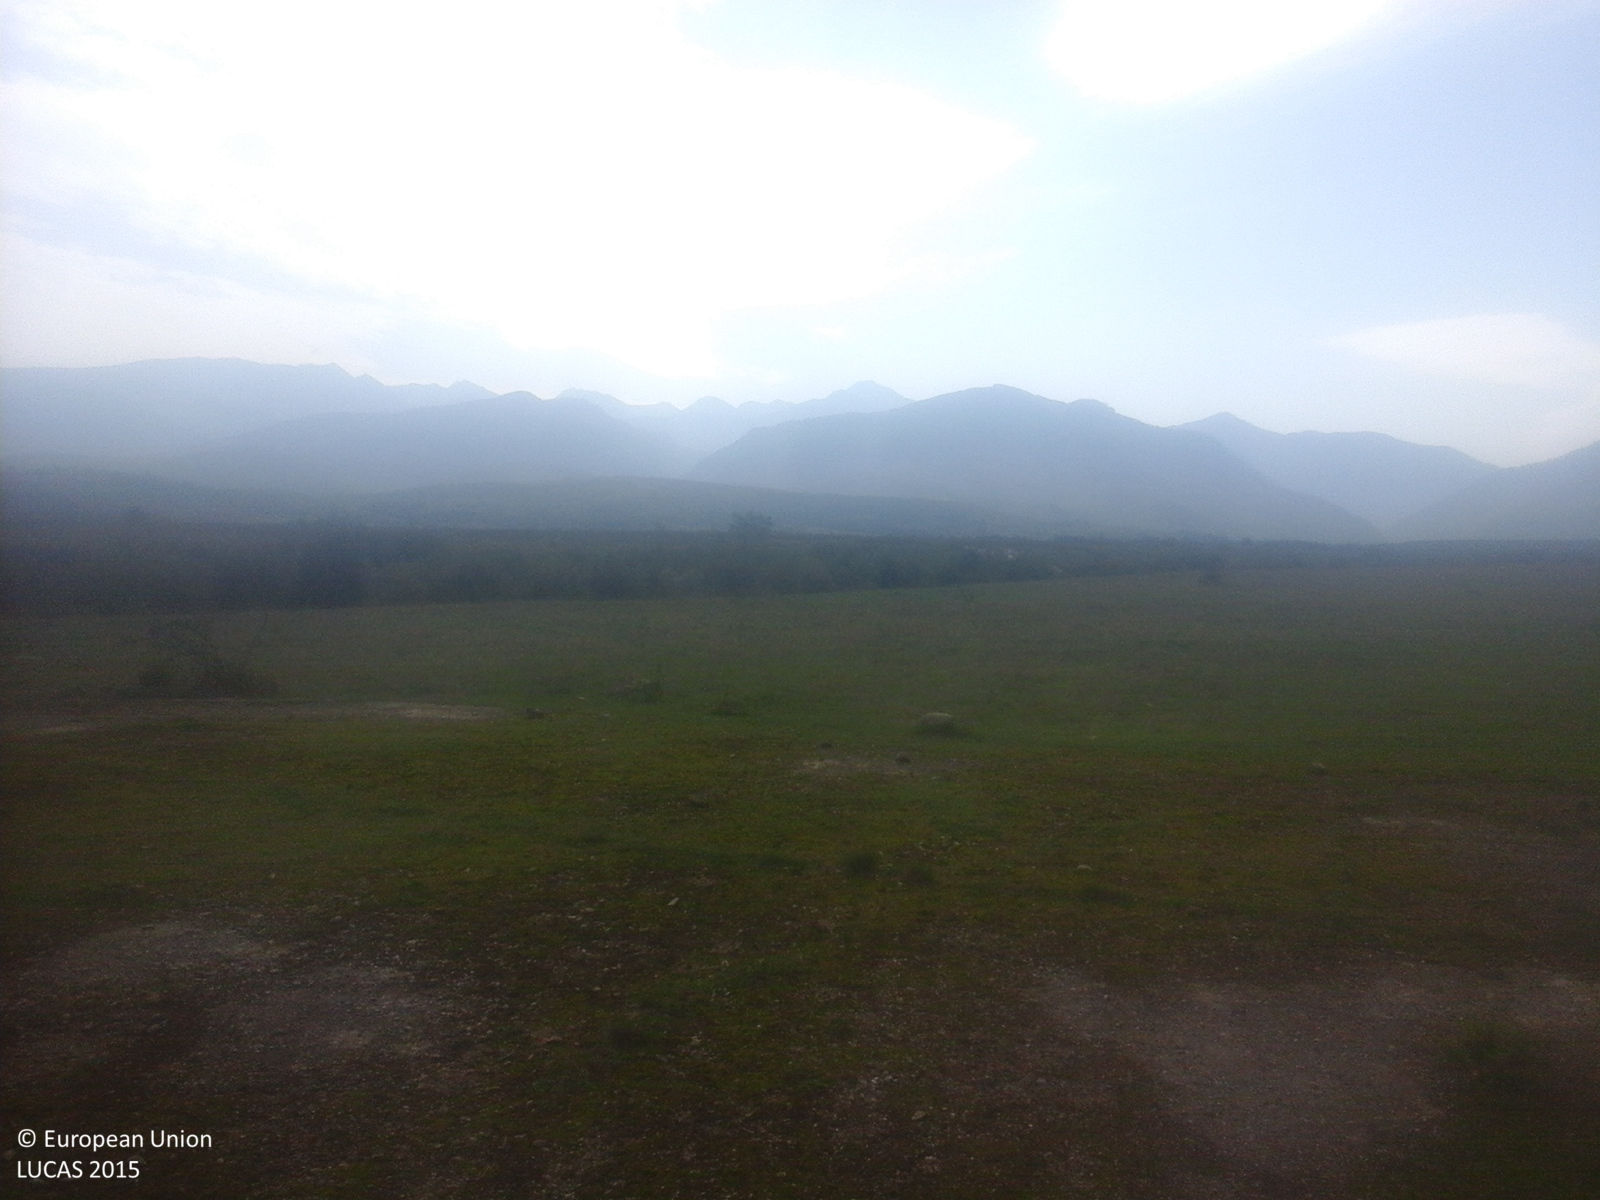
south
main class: Grassland
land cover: Grassland without tree/shrub cover
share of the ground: > 75 %
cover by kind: herbaceous plants 100 %
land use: Agriculture (excluding fallow land and kitchen gardens)
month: September
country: RO
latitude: 45.5336
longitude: 22.8691
